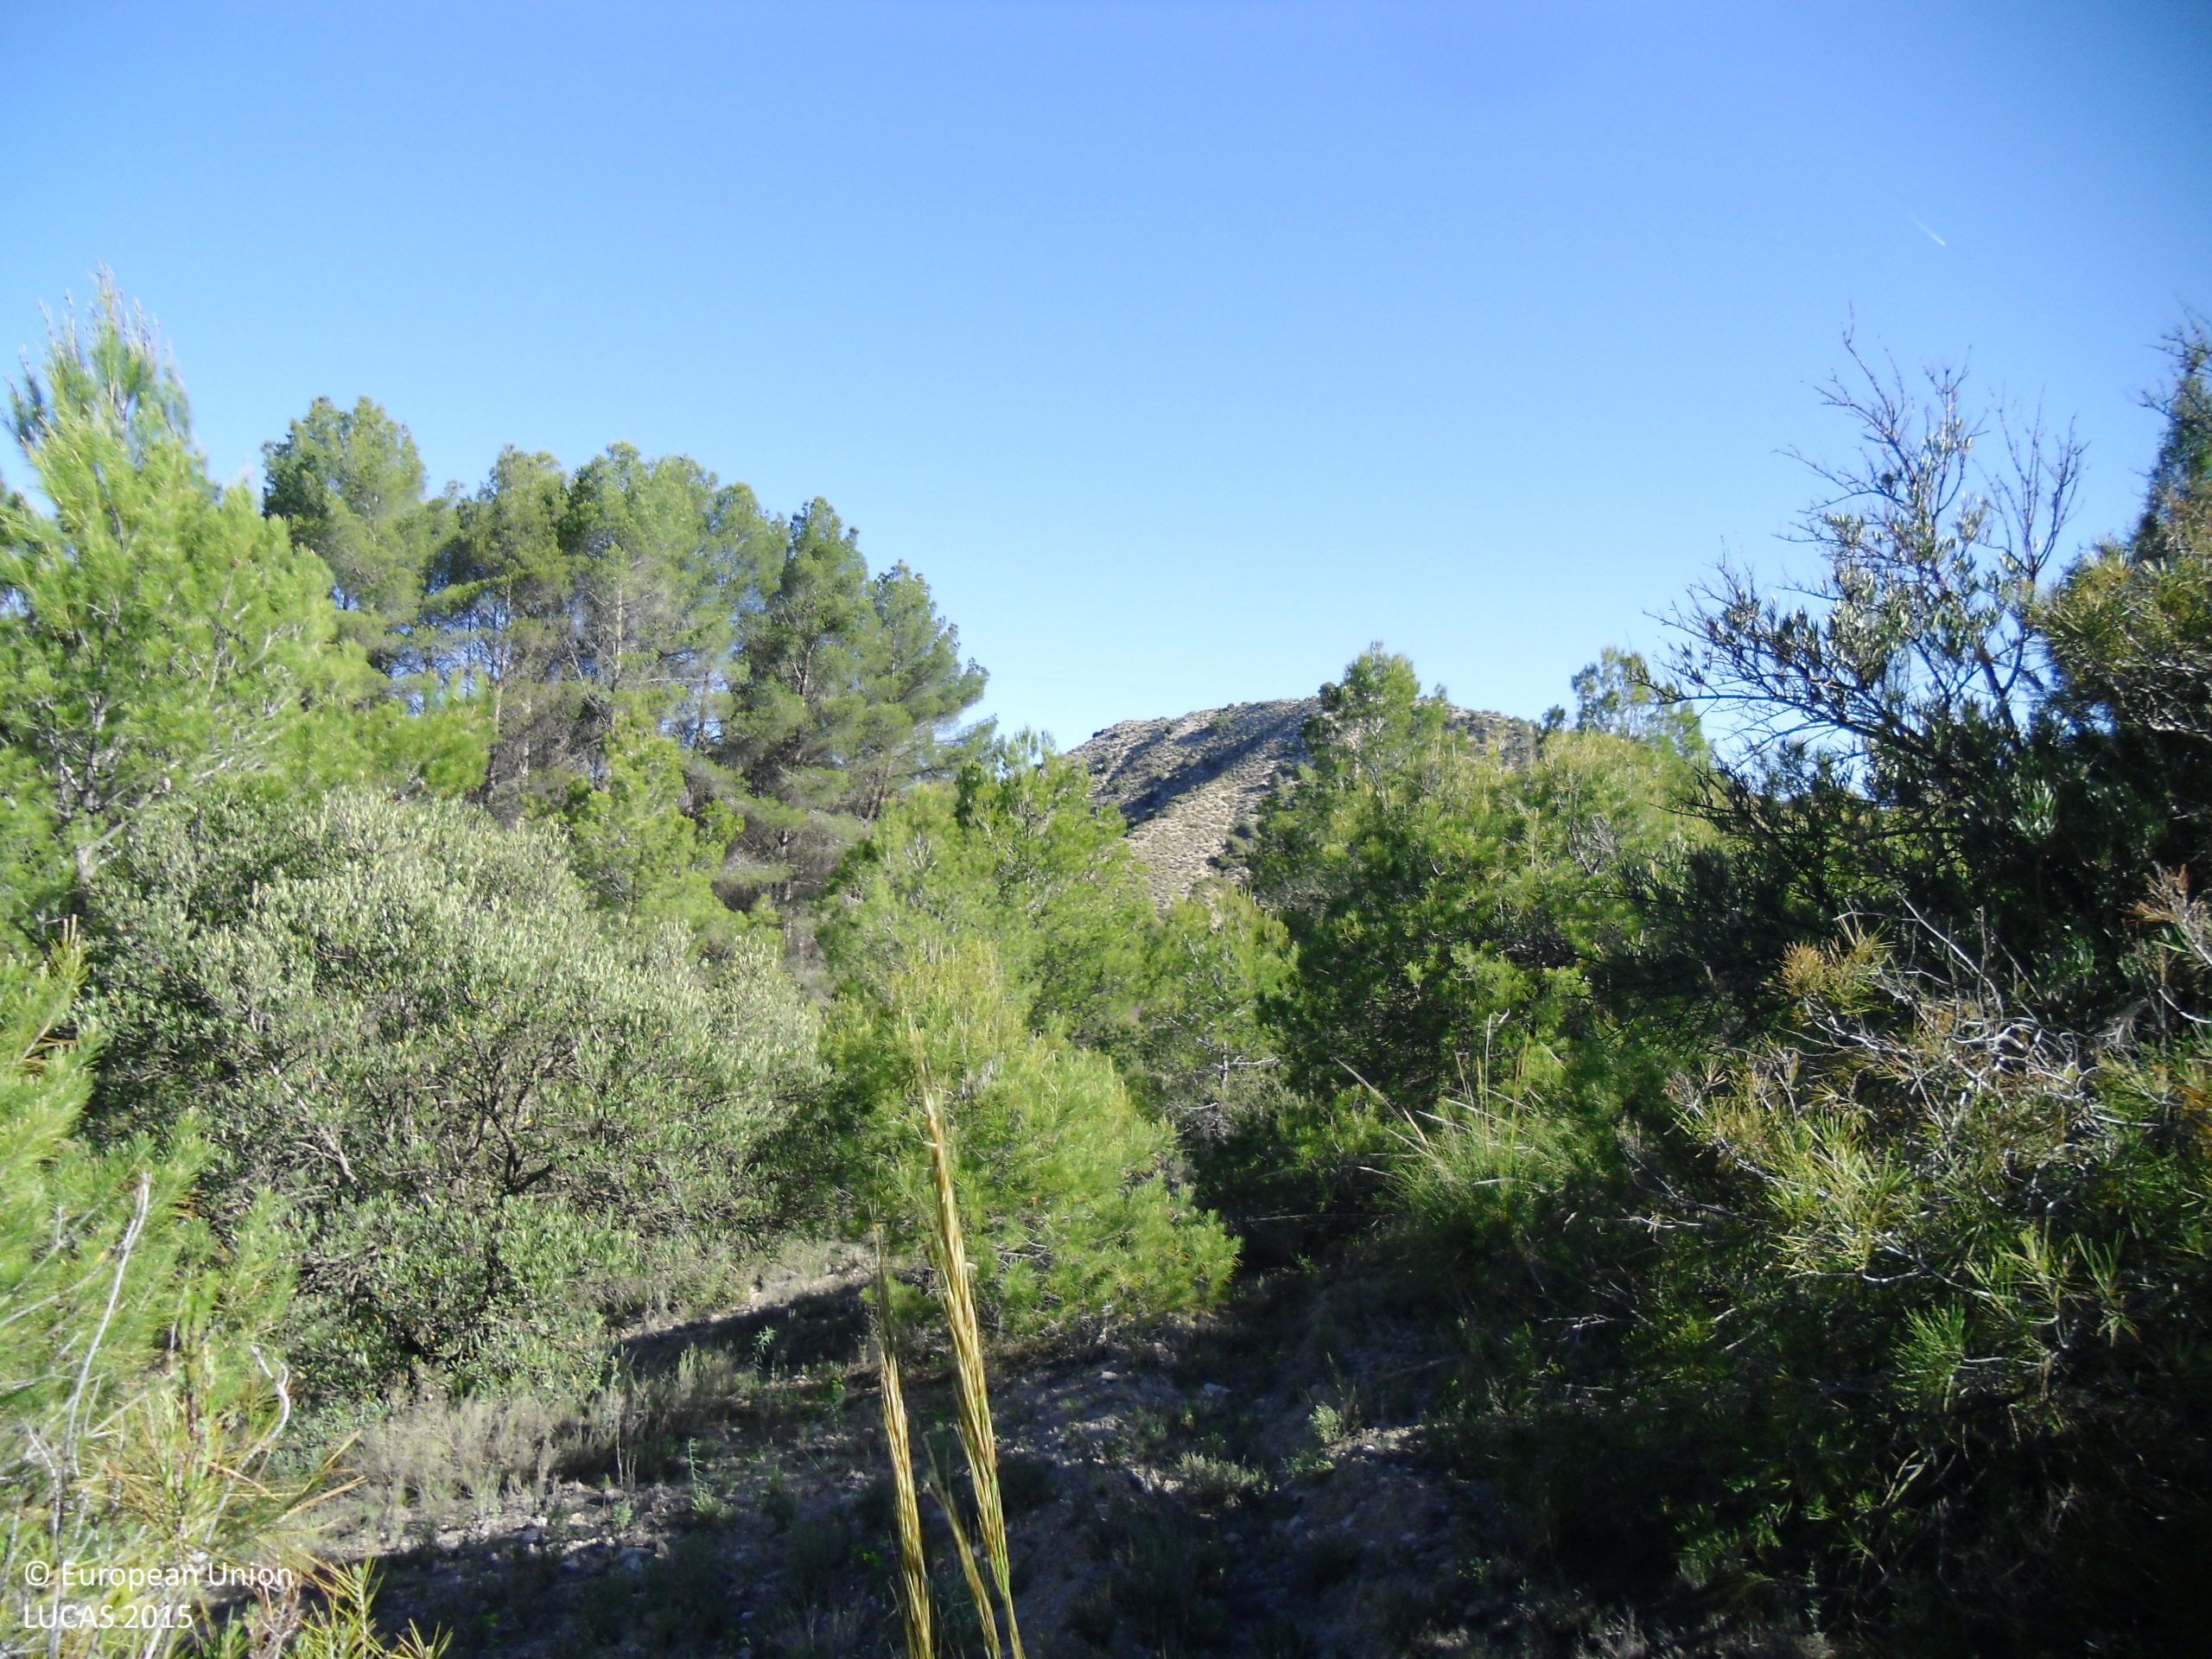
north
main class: Woodland
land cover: Pine dominated coniferous woodland
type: coniferous forest of the mediterranean region
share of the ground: 25 - 50 %
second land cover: Olive groves
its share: 50 - 75 %
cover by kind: coniferous forest trees 50 %, herbaceous plants 30 %, shrubs 20 %
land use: Forestry
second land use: Agriculture (excluding fallow land and kitchen gardens)
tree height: > 5 m
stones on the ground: 10 - 25 %
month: May
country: ES
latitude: 40.2743
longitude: -2.8799
